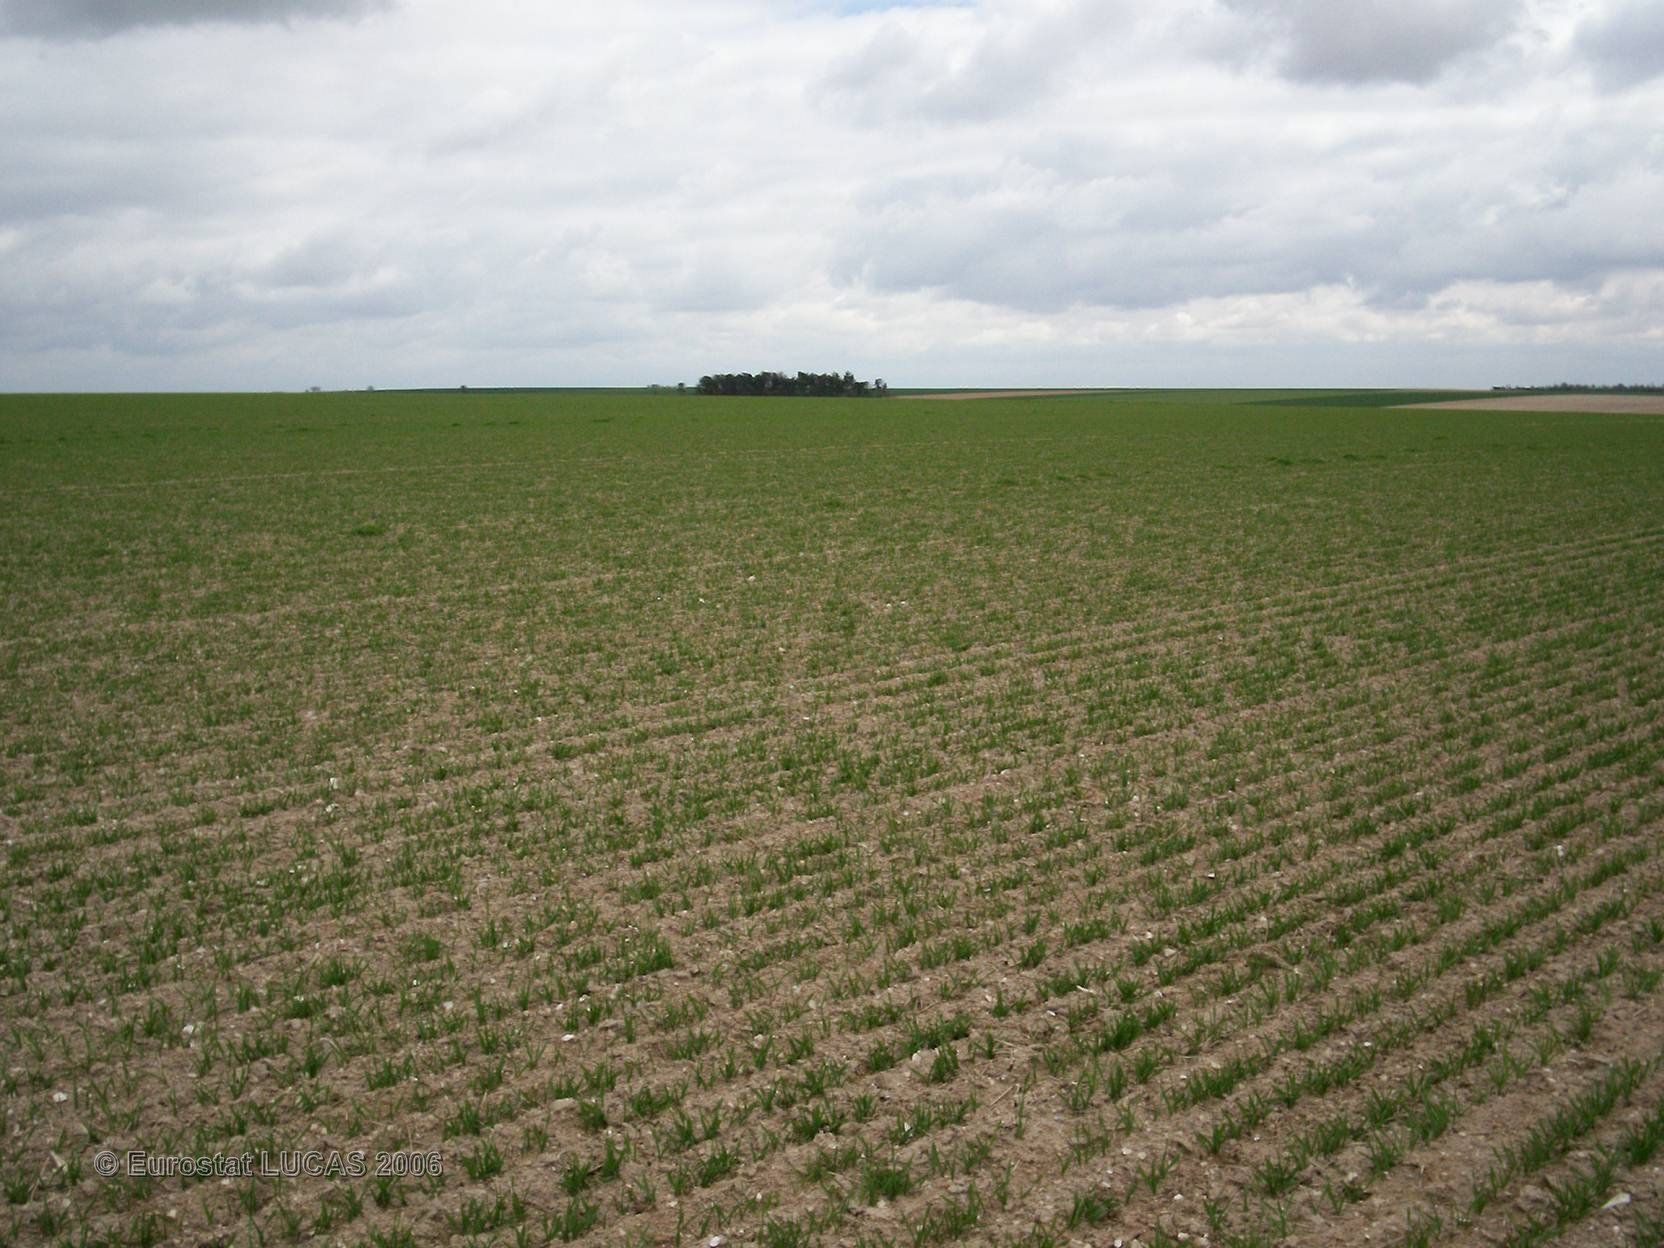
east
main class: Cropland
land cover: Barley
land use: Agriculture (excluding fallow land and kitchen gardens)
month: April
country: FR
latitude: 48.4918
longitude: 3.9742
